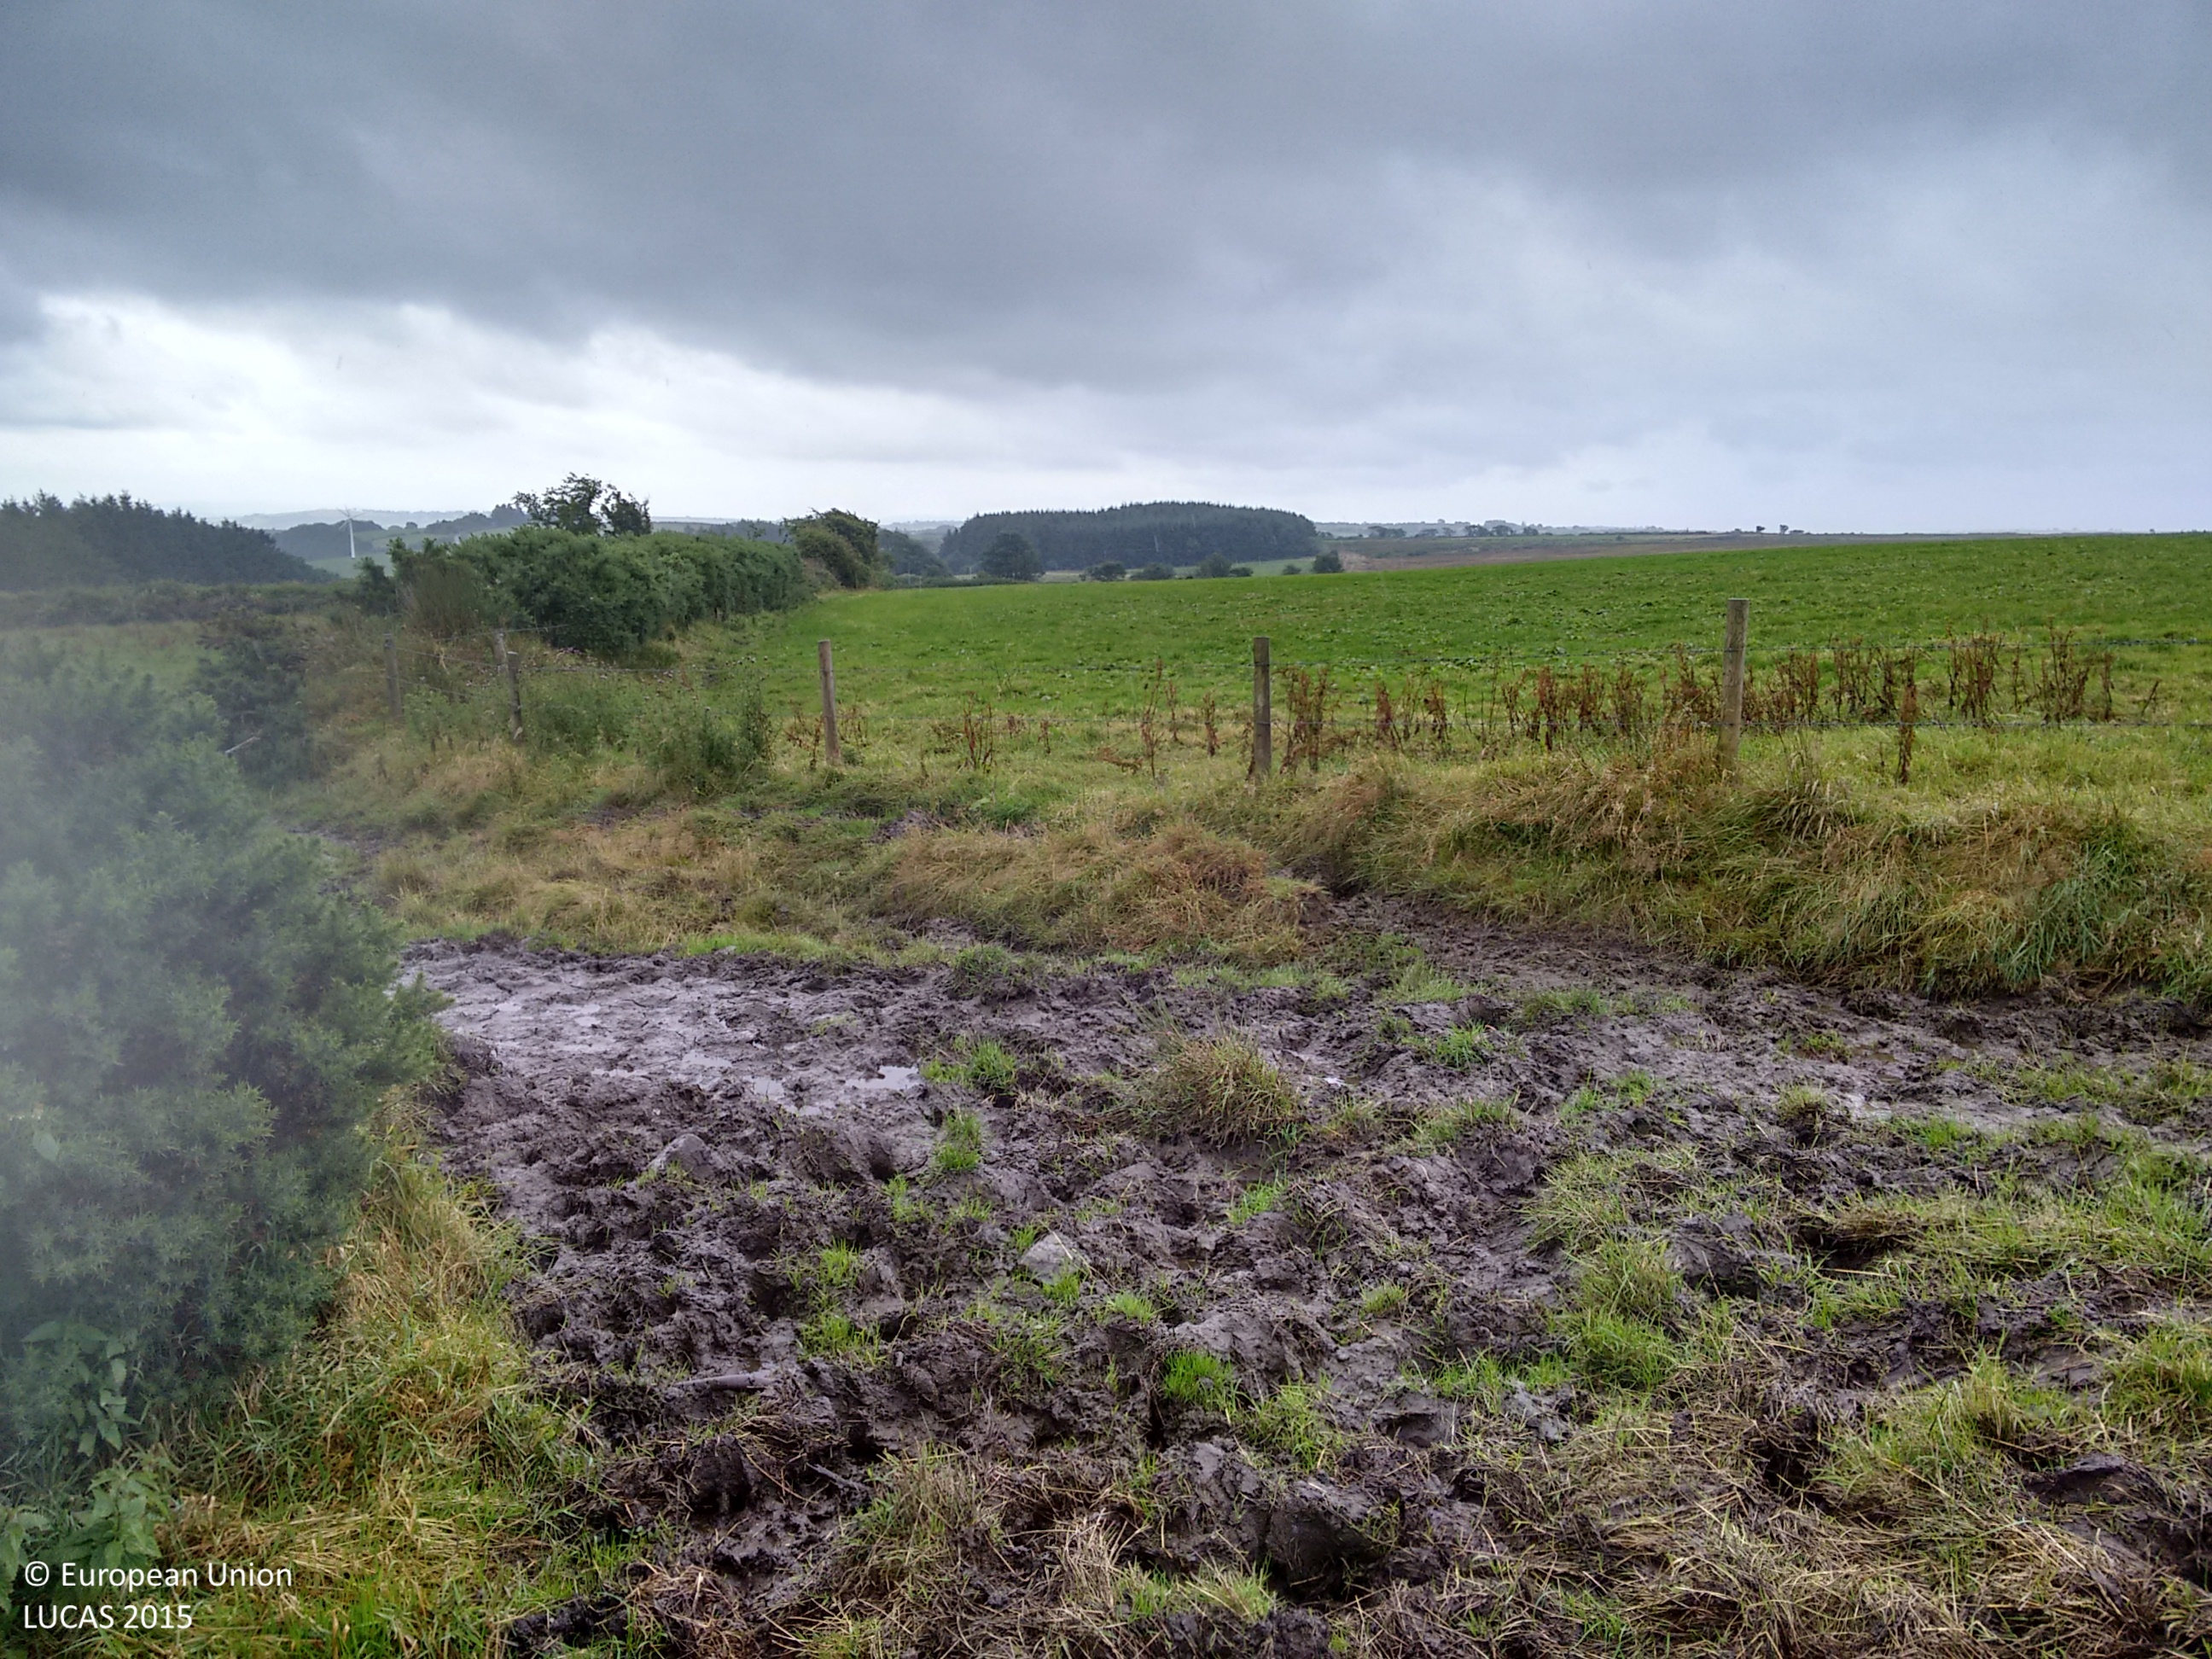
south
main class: Grassland
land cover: Grassland without tree/shrub cover
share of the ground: > 75 %
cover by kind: herbaceous plants 80 %, unconsolidated bare surface 20 %
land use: Agriculture (excluding fallow land and kitchen gardens)
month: August
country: GB
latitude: 51.9670
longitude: -4.4112
